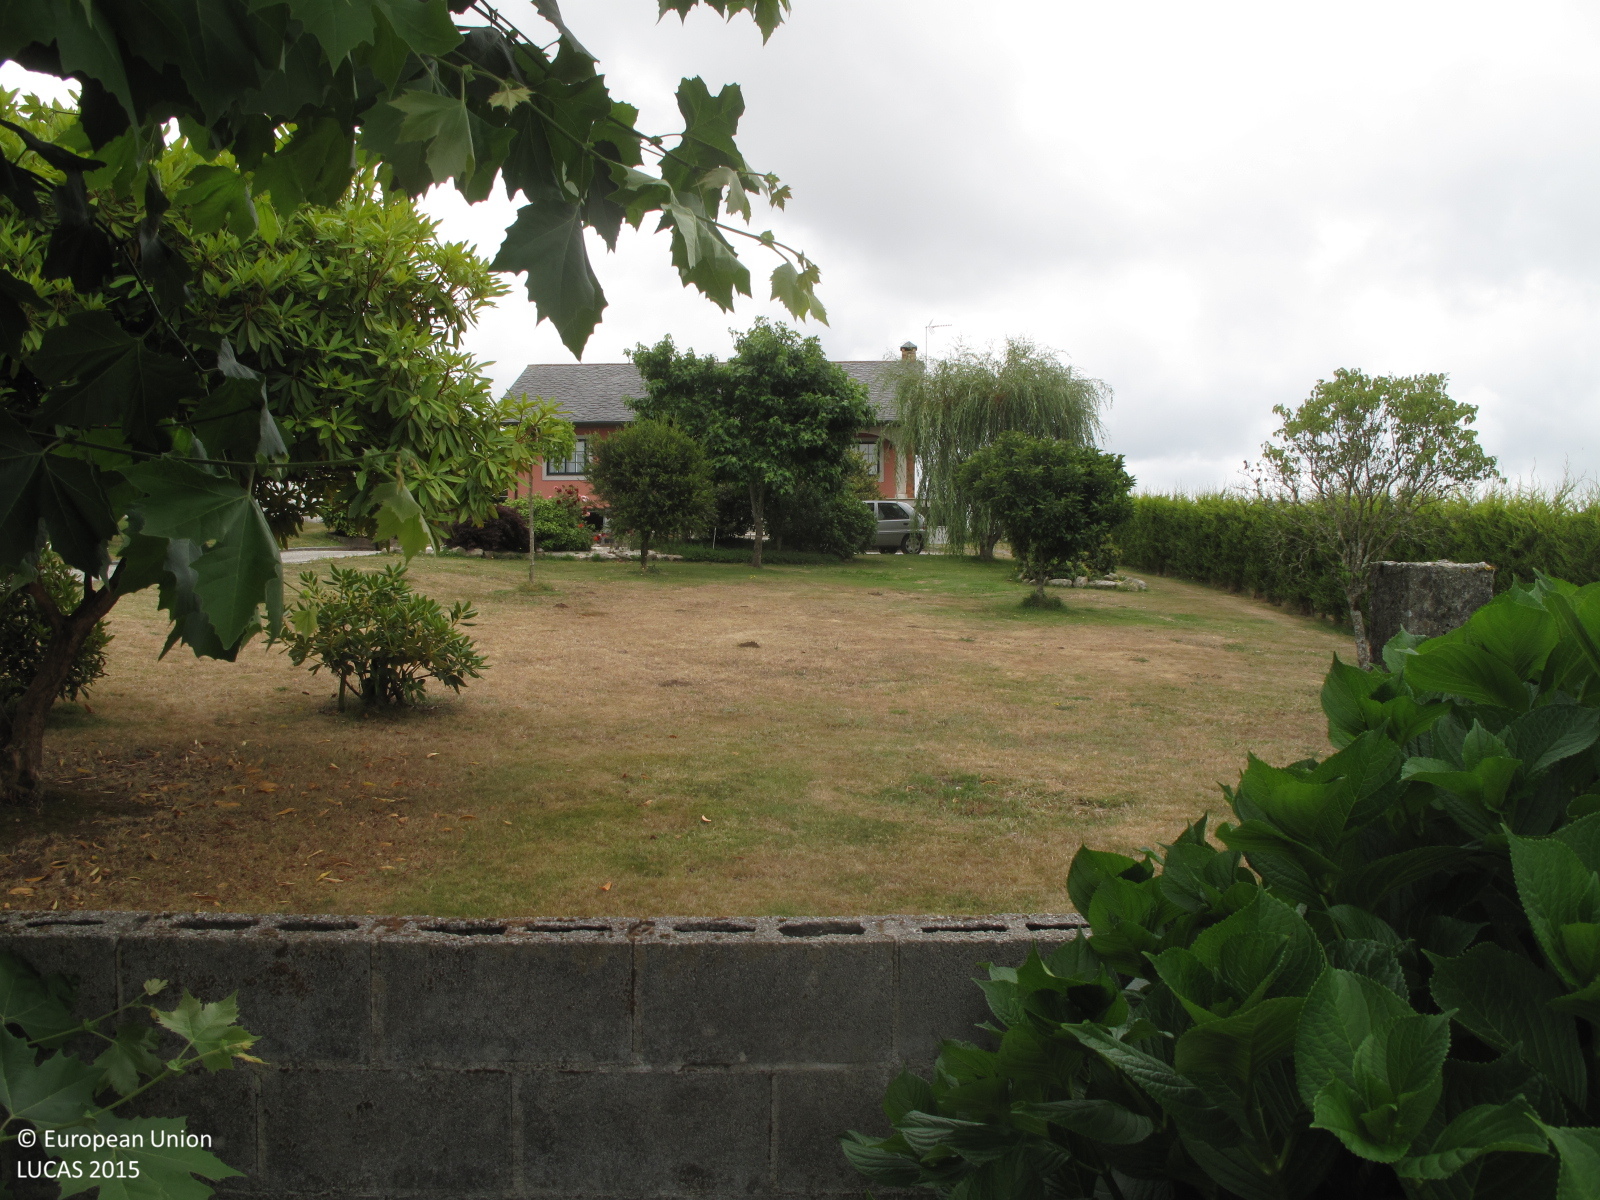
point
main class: Grassland
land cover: Grassland with sparse tree/shrub cover
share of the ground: > 75 %
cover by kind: herbaceous plants 90 %, broadleaved forest trees 5 %, shrubs 5 %
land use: Residential
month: July
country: ES
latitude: 43.4520
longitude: -8.0528
